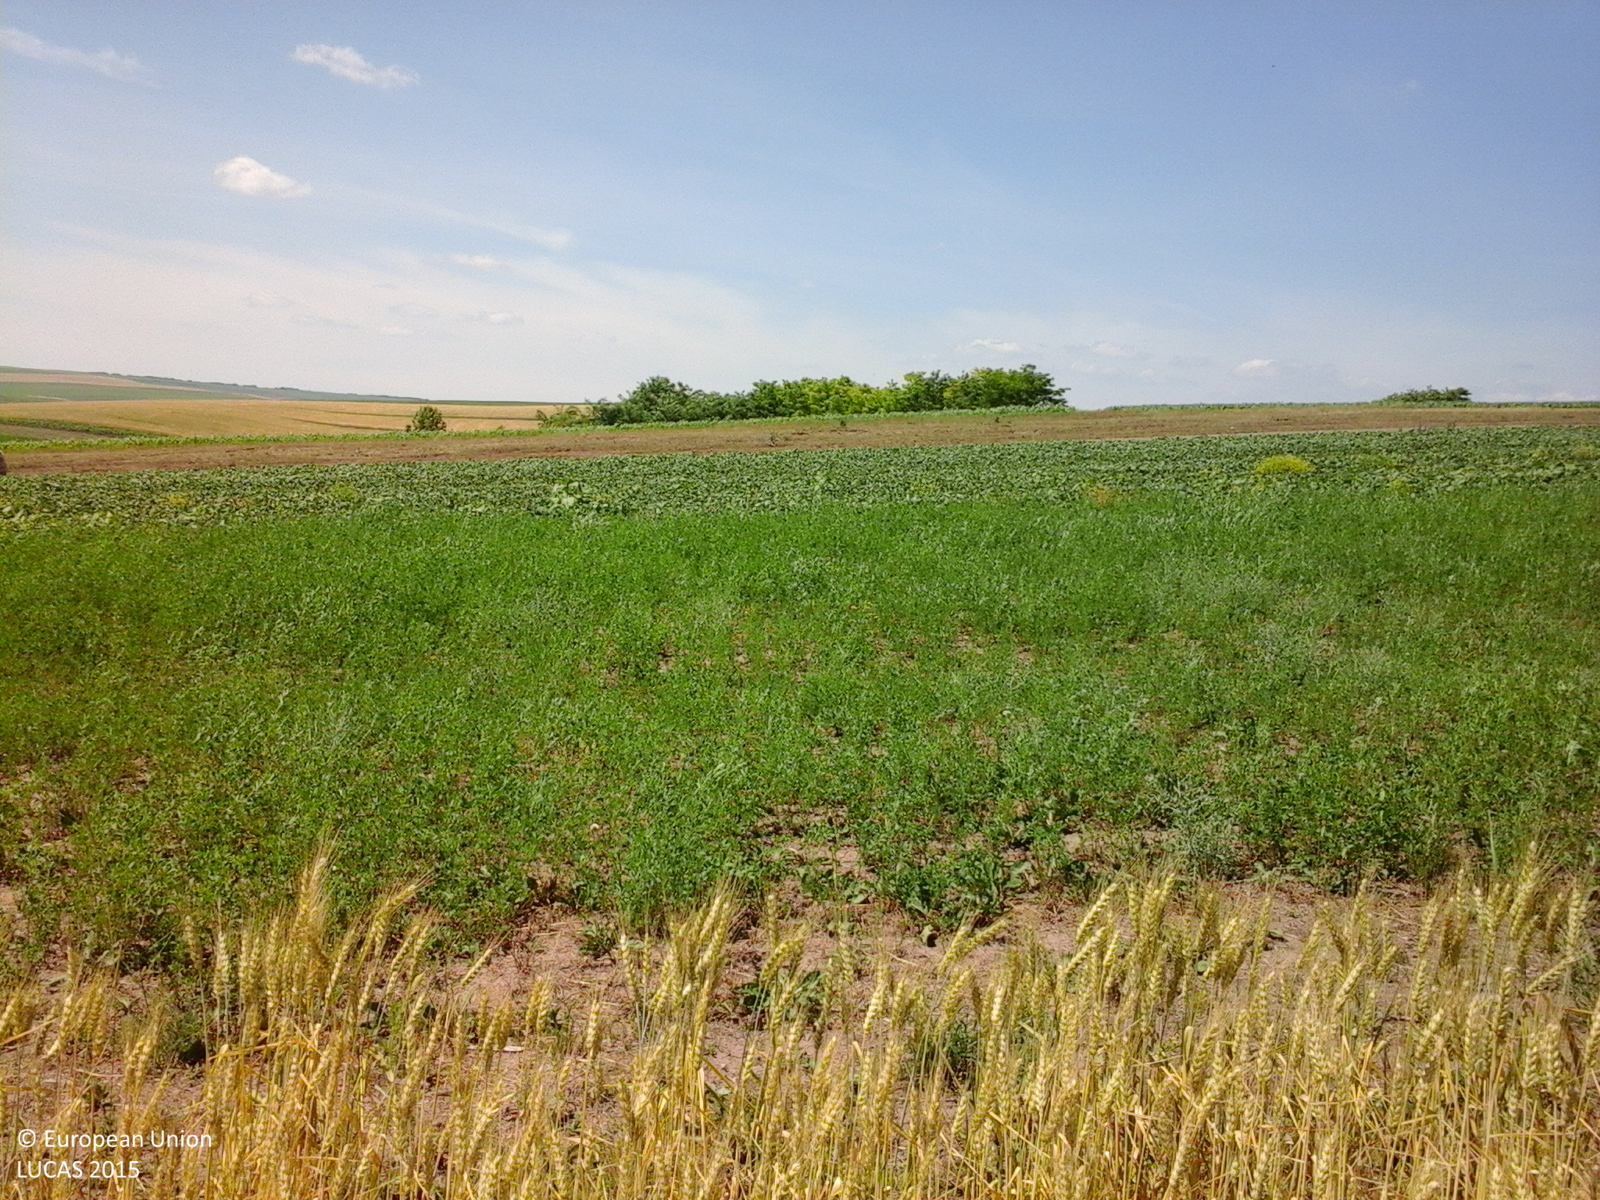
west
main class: Cropland
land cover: Common wheat
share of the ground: > 75 %
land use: Agriculture (excluding fallow land and kitchen gardens)
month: June
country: RO
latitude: 48.1096
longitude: 26.9619
